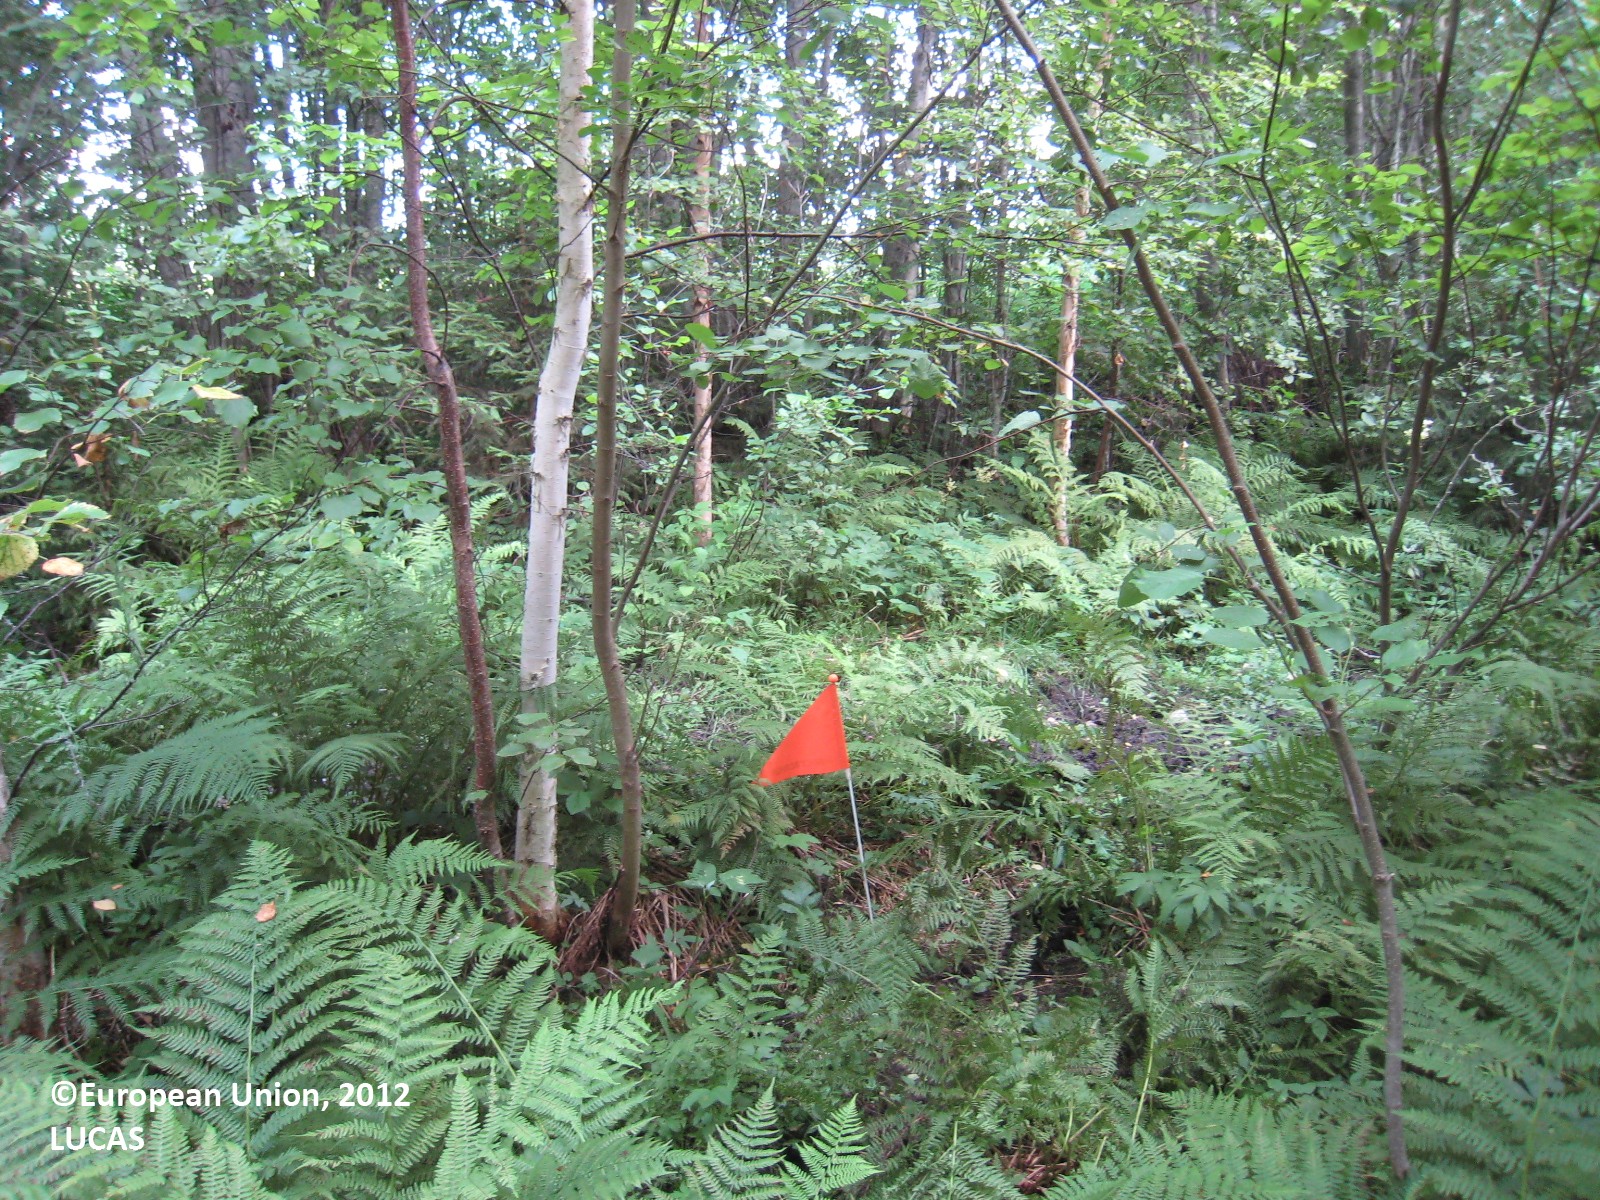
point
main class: Woodland
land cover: Broadleaved woodland
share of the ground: > 75 %
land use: Forestry
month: July
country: FI
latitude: 61.6988
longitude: 26.1117
